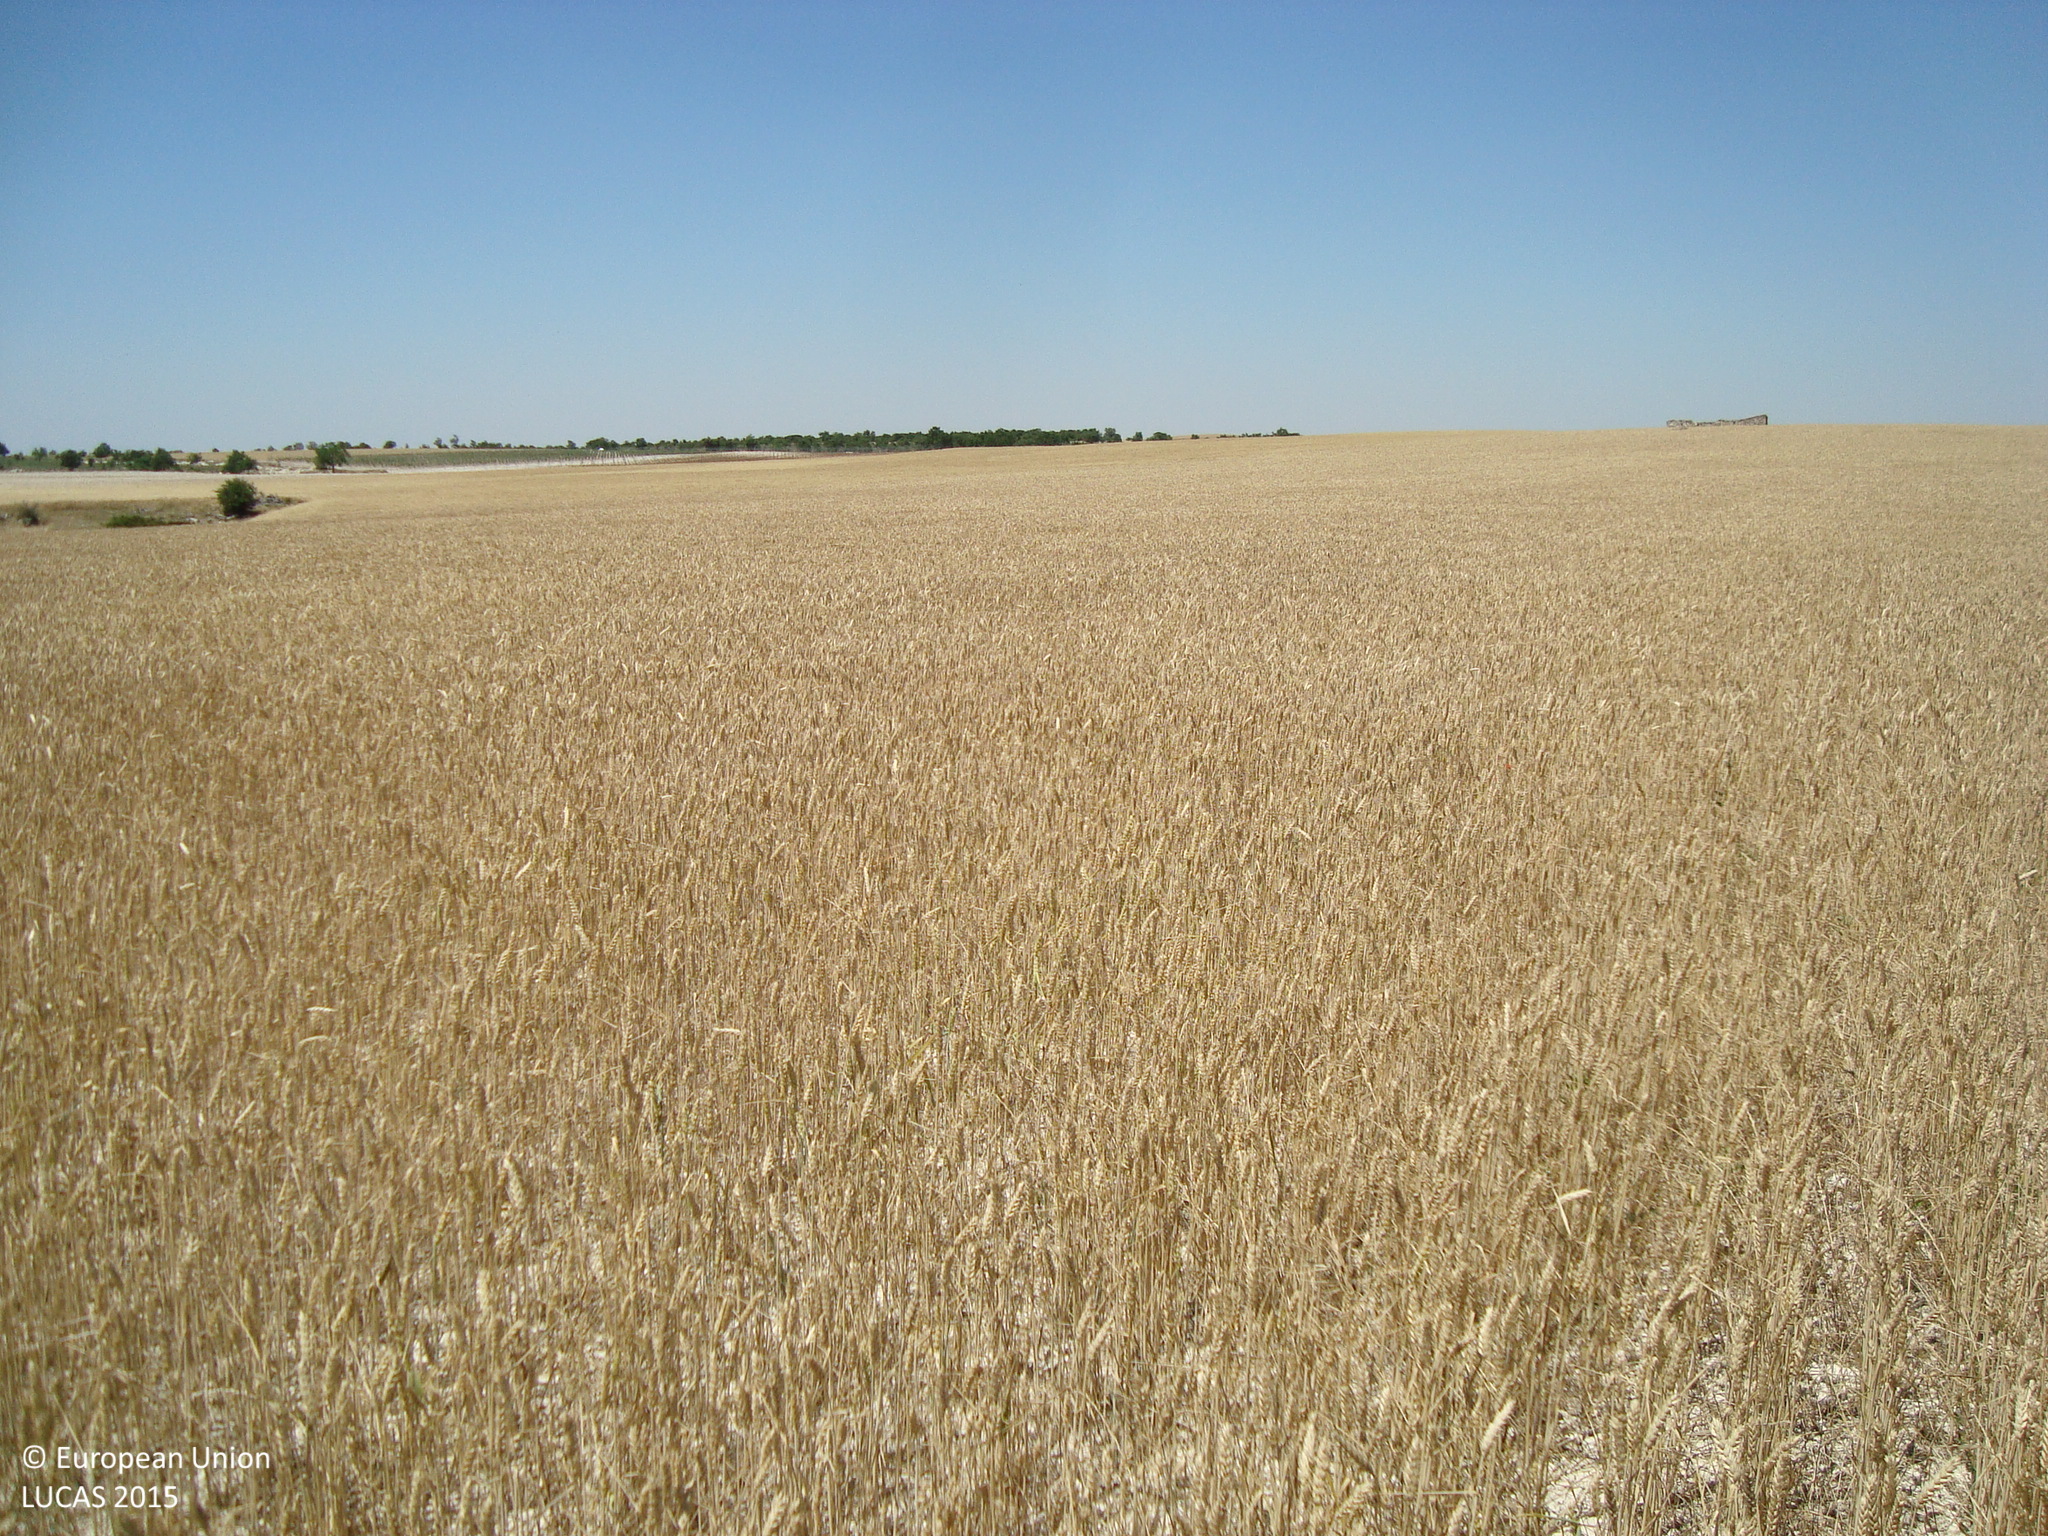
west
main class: Cropland
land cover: Common wheat
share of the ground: 50 - 75 %
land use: Agriculture (excluding fallow land and kitchen gardens)
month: June
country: ES
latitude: 41.7798
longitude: -3.7833
